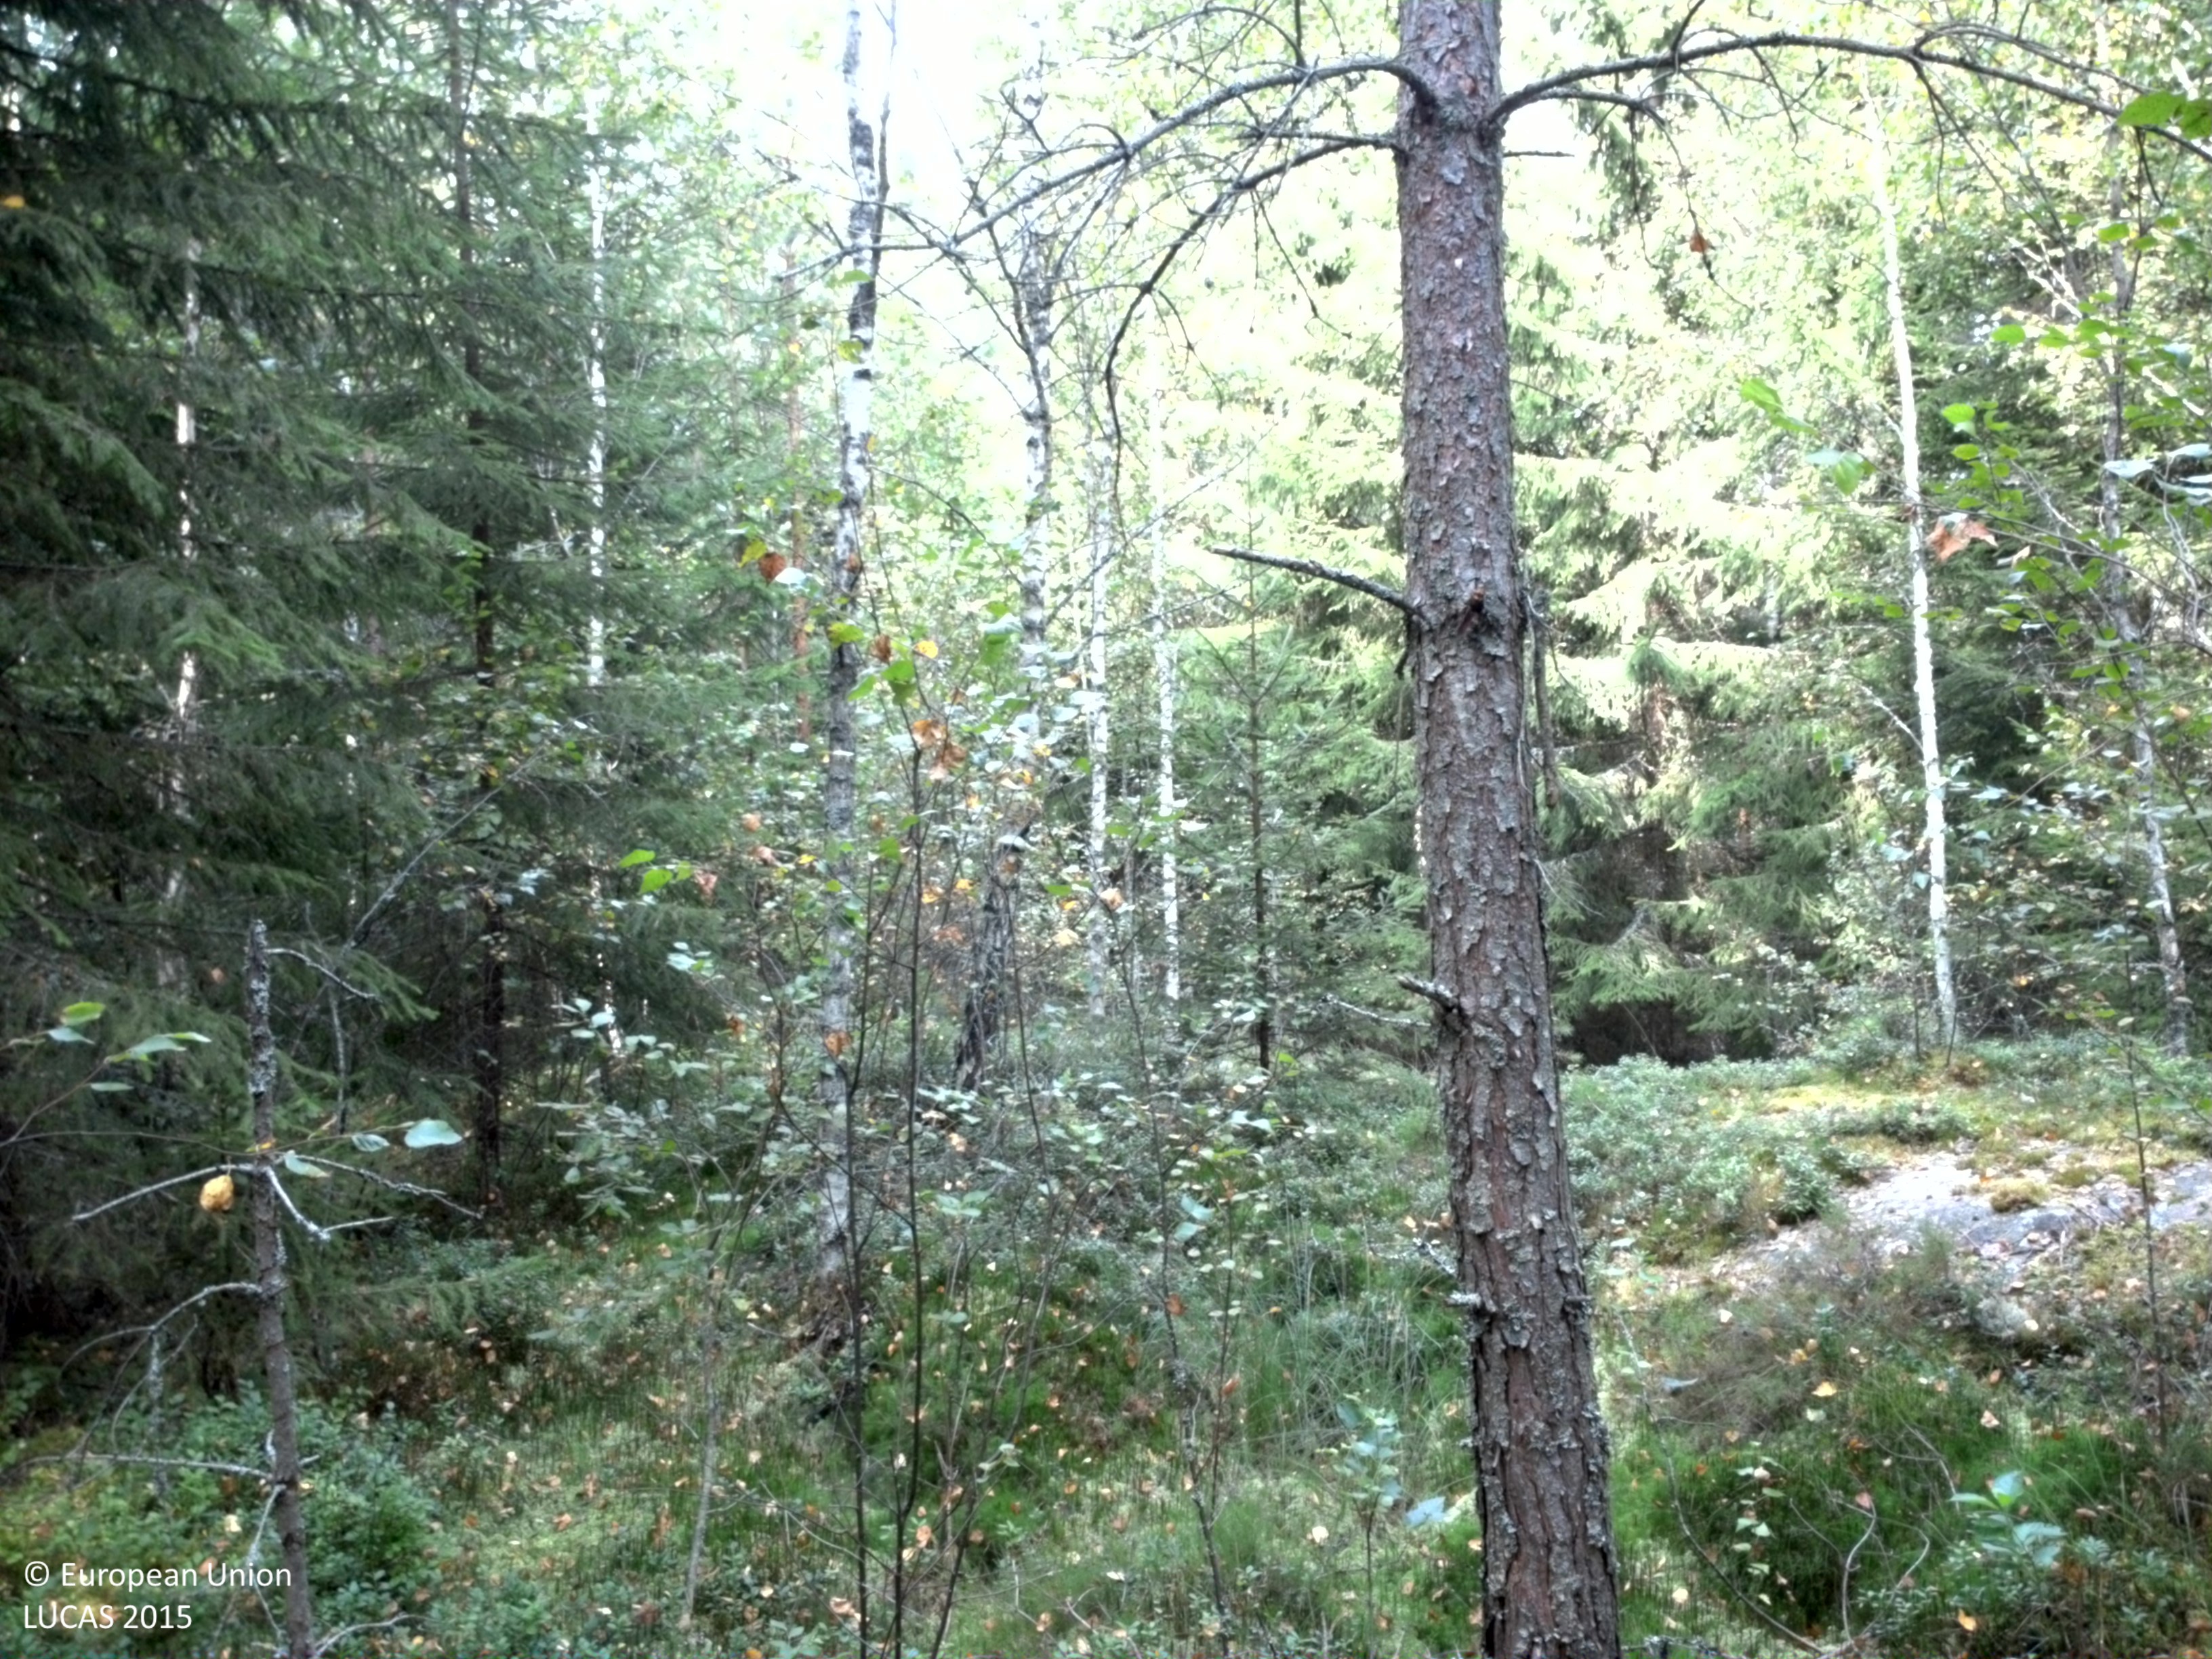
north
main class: Woodland
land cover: Pine dominated mixed woodland
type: boreal forest
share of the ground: 50 - 75 %
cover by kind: coniferous forest trees 55 %, broadleaved forest trees 20 %, lichens and mosses 20 %, shrubs 5 %
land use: Forestry
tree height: > 5 m
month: August
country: SE
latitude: 59.6160
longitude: 13.4481
